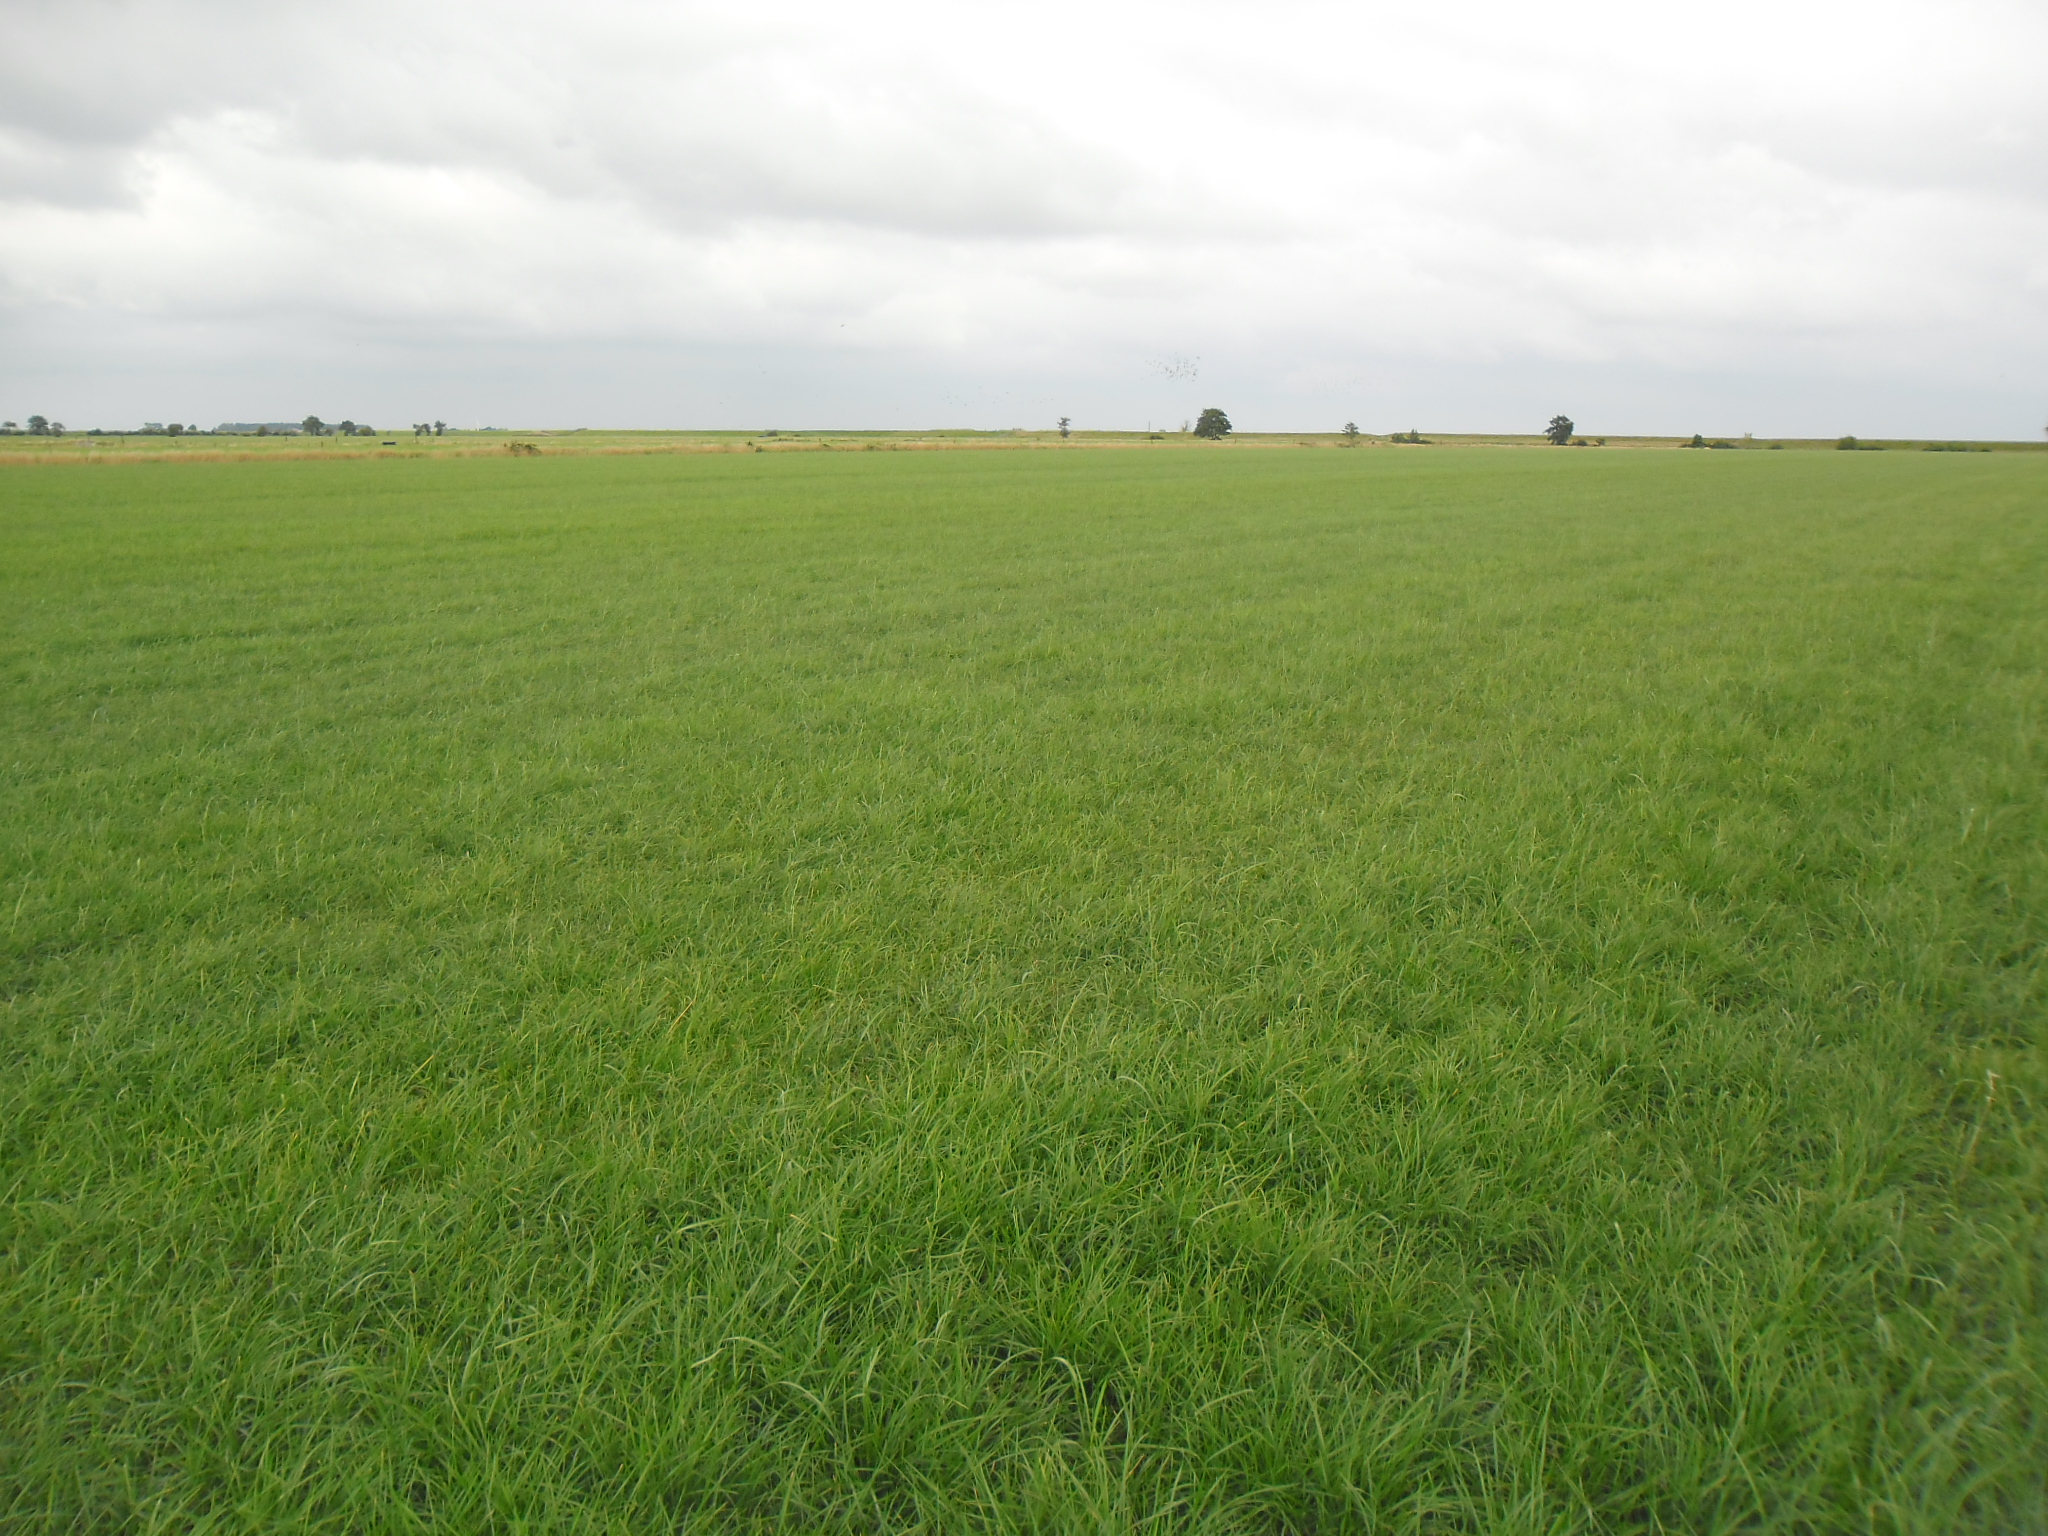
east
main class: Grassland
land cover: Grassland without tree/shrub cover
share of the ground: > 75 %
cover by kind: herbaceous plants 100 %
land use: Agriculture (excluding fallow land and kitchen gardens)
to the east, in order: Grassland without tree/shrub cover; Grass margins; Fences; Grassland without tree/shrub cover; Fences; Grass margins; Ditches and canals; Grass margins; Fences; Tracks; Fences; Grassland without tree/shrub cover
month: August
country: NL
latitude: 52.8536
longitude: 5.5882
